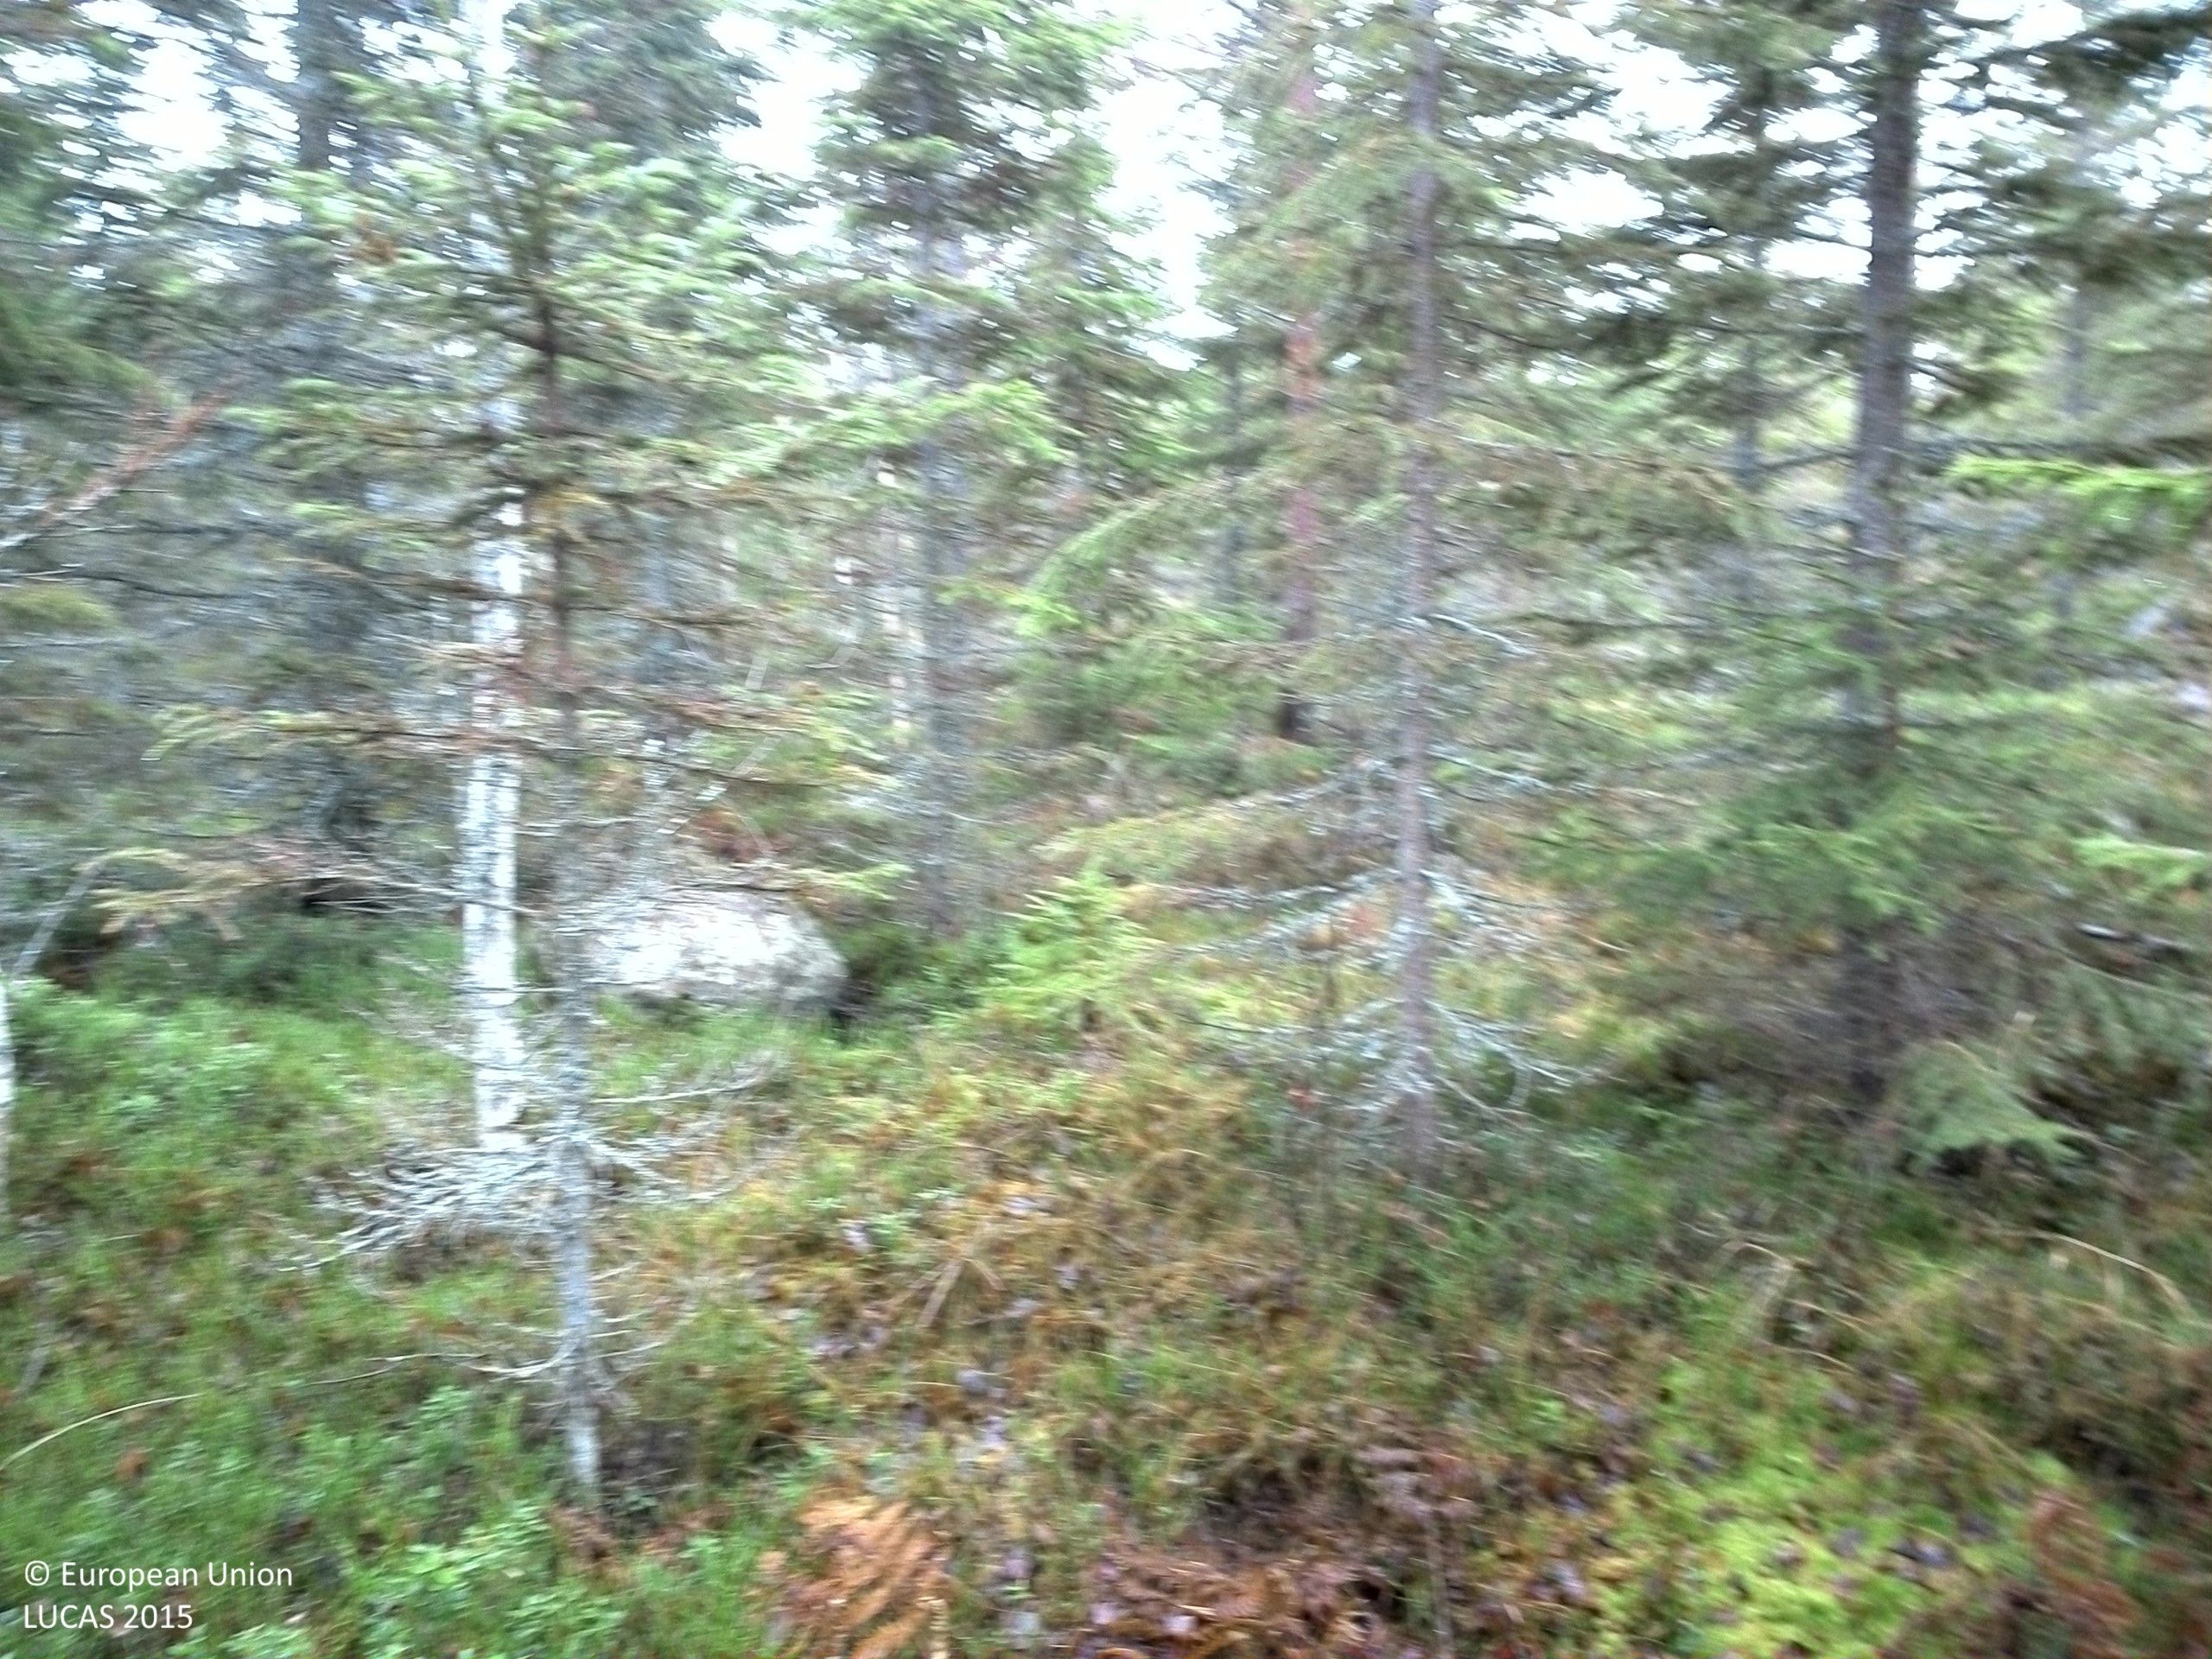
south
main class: Woodland
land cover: Spruce dominated mixed woodland
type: boreal forest
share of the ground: > 75 %
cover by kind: coniferous forest trees 55 %, broadleaved forest trees 20 %, shrubs 20 %, lichens and mosses 5 %
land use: Forestry
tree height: > 5 m
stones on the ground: < 10 %
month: November
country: SE
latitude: 60.2669
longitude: 14.6343
